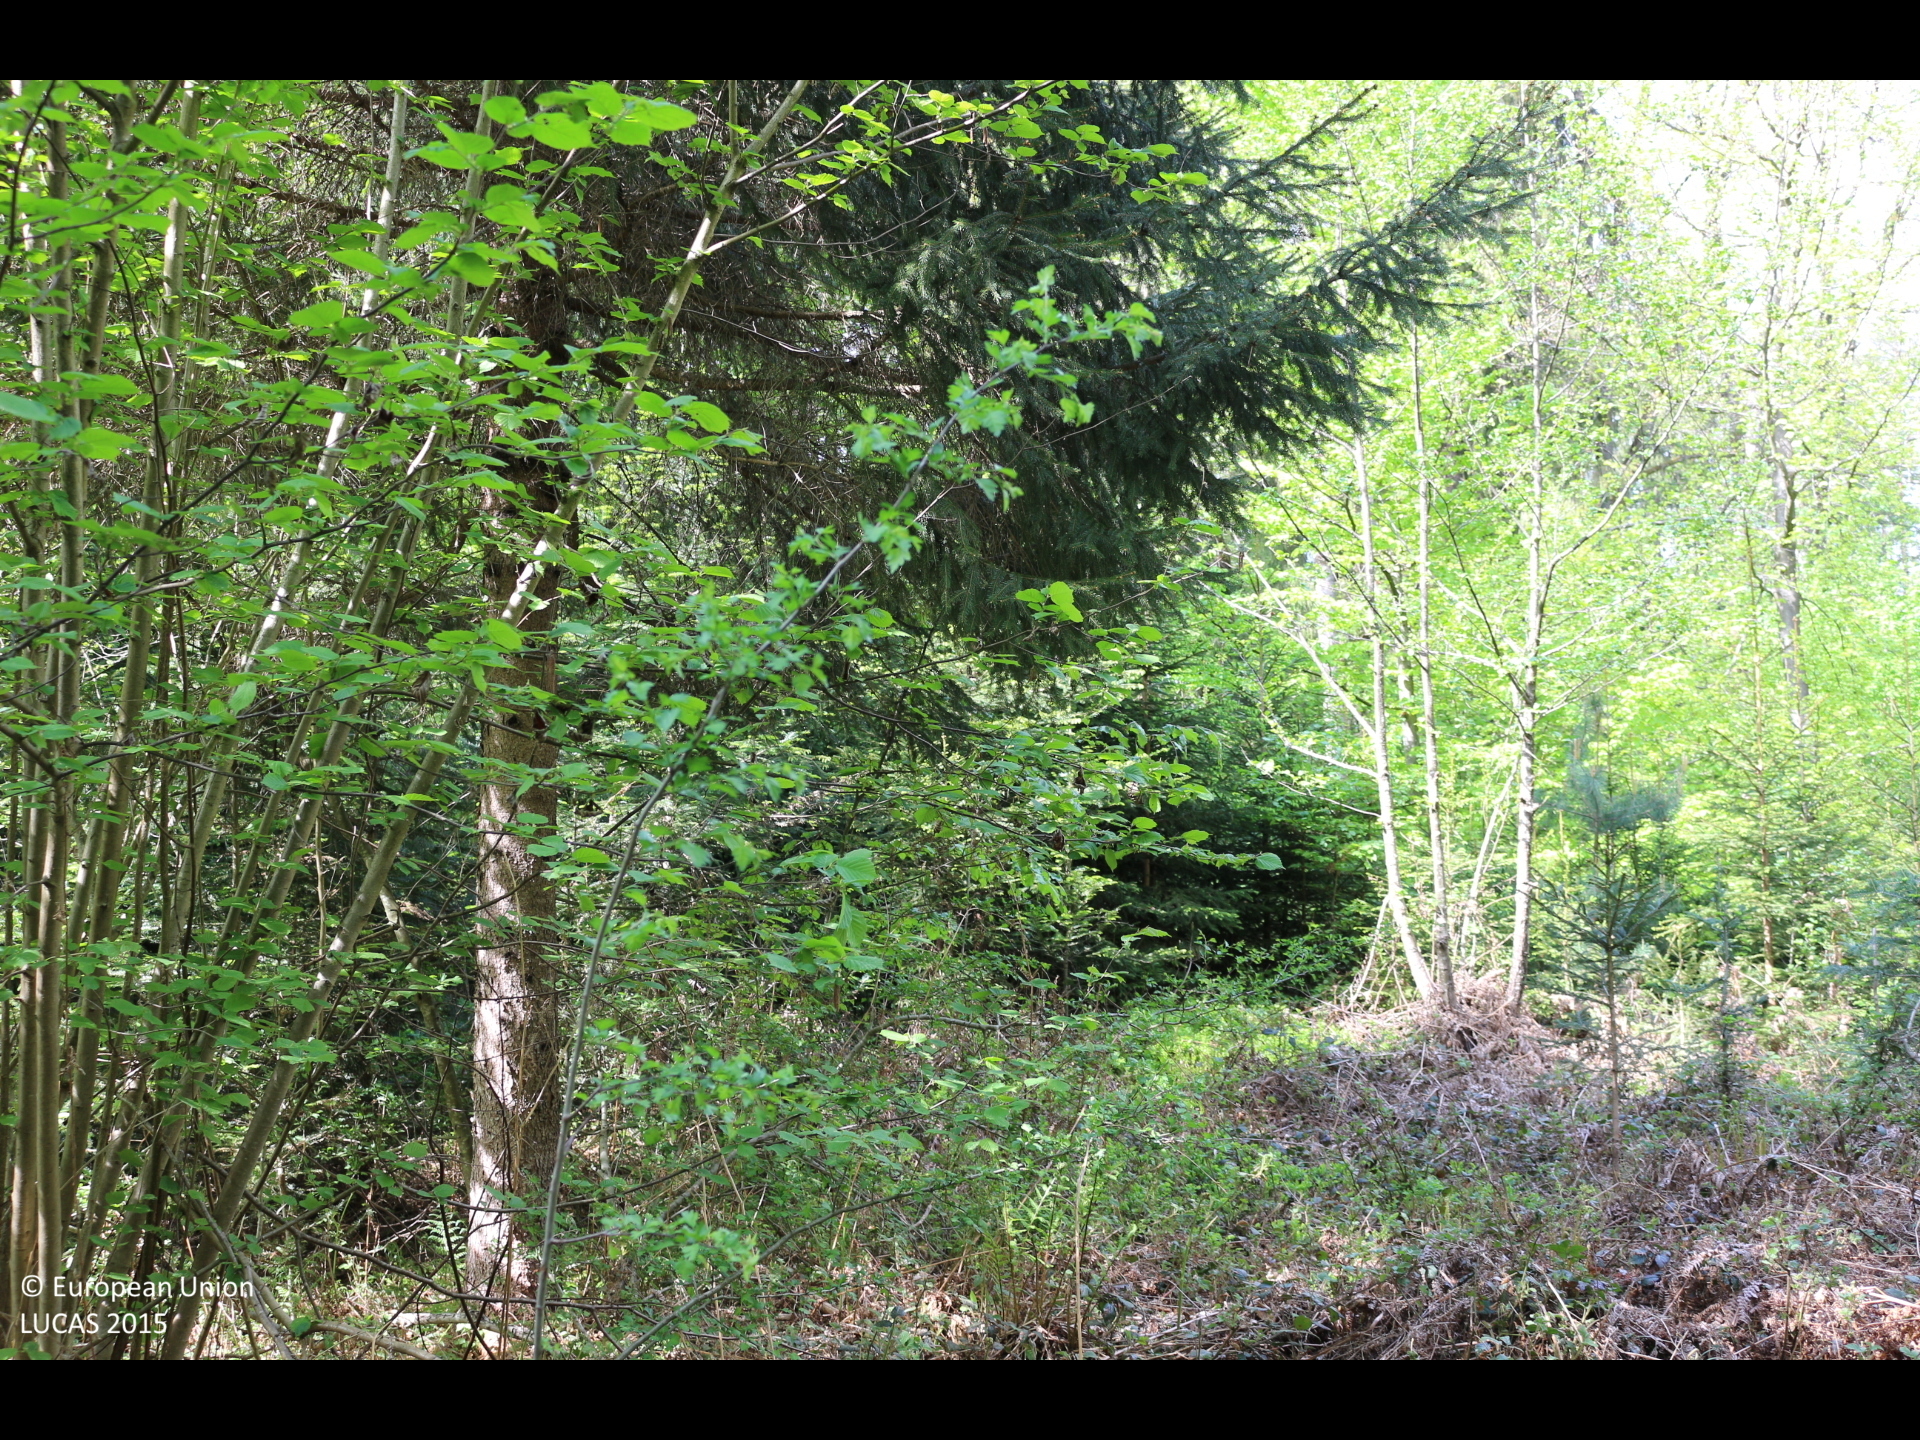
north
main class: Woodland
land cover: Spruce dominated mixed woodland
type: mountainous beech forest
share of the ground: > 75 %
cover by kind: broadleaved forest trees 50 %, coniferous forest trees 40 %, shrubs 10 %
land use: Forestry
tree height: > 5 m
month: May
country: AT
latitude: 46.6468
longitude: 14.2176
